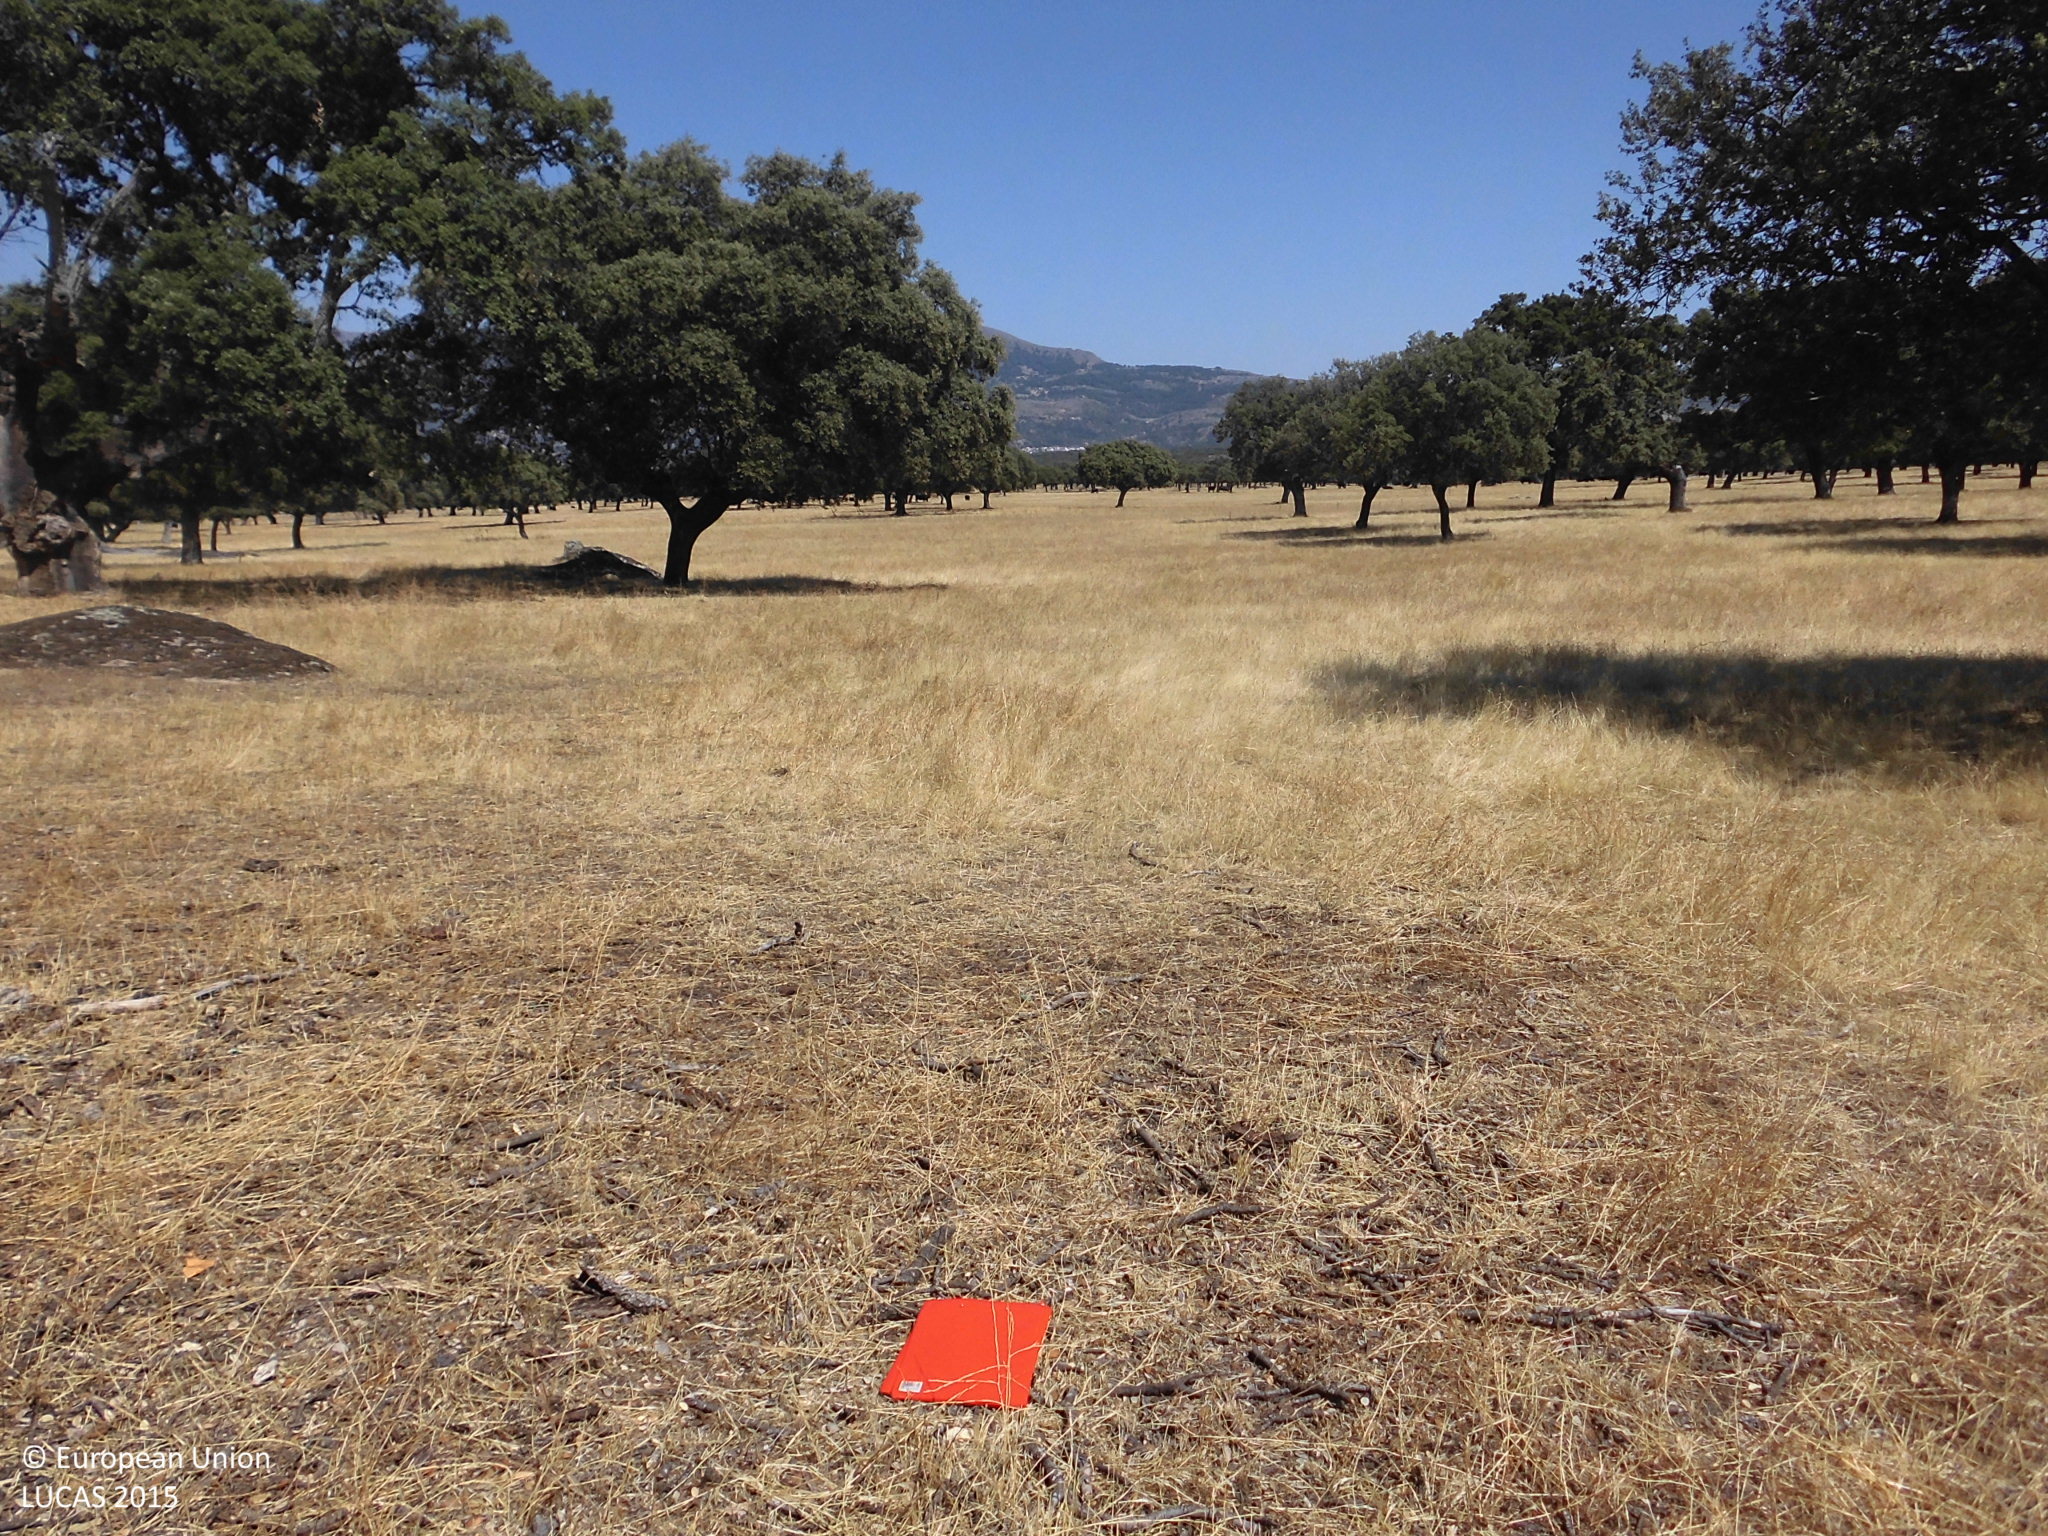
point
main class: Woodland
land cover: Broadleaved woodland
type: broadleaved evergreen forest
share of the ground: 25 - 50 %
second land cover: Grassland without tree/shrub cover
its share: > 75 %
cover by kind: herbaceous plants 70 %, broadleaved forest trees 30 %
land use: Forestry
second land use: Agriculture (excluding fallow land and kitchen gardens)
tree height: > 5 m
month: July
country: ES
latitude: 40.1609
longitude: -6.1000
